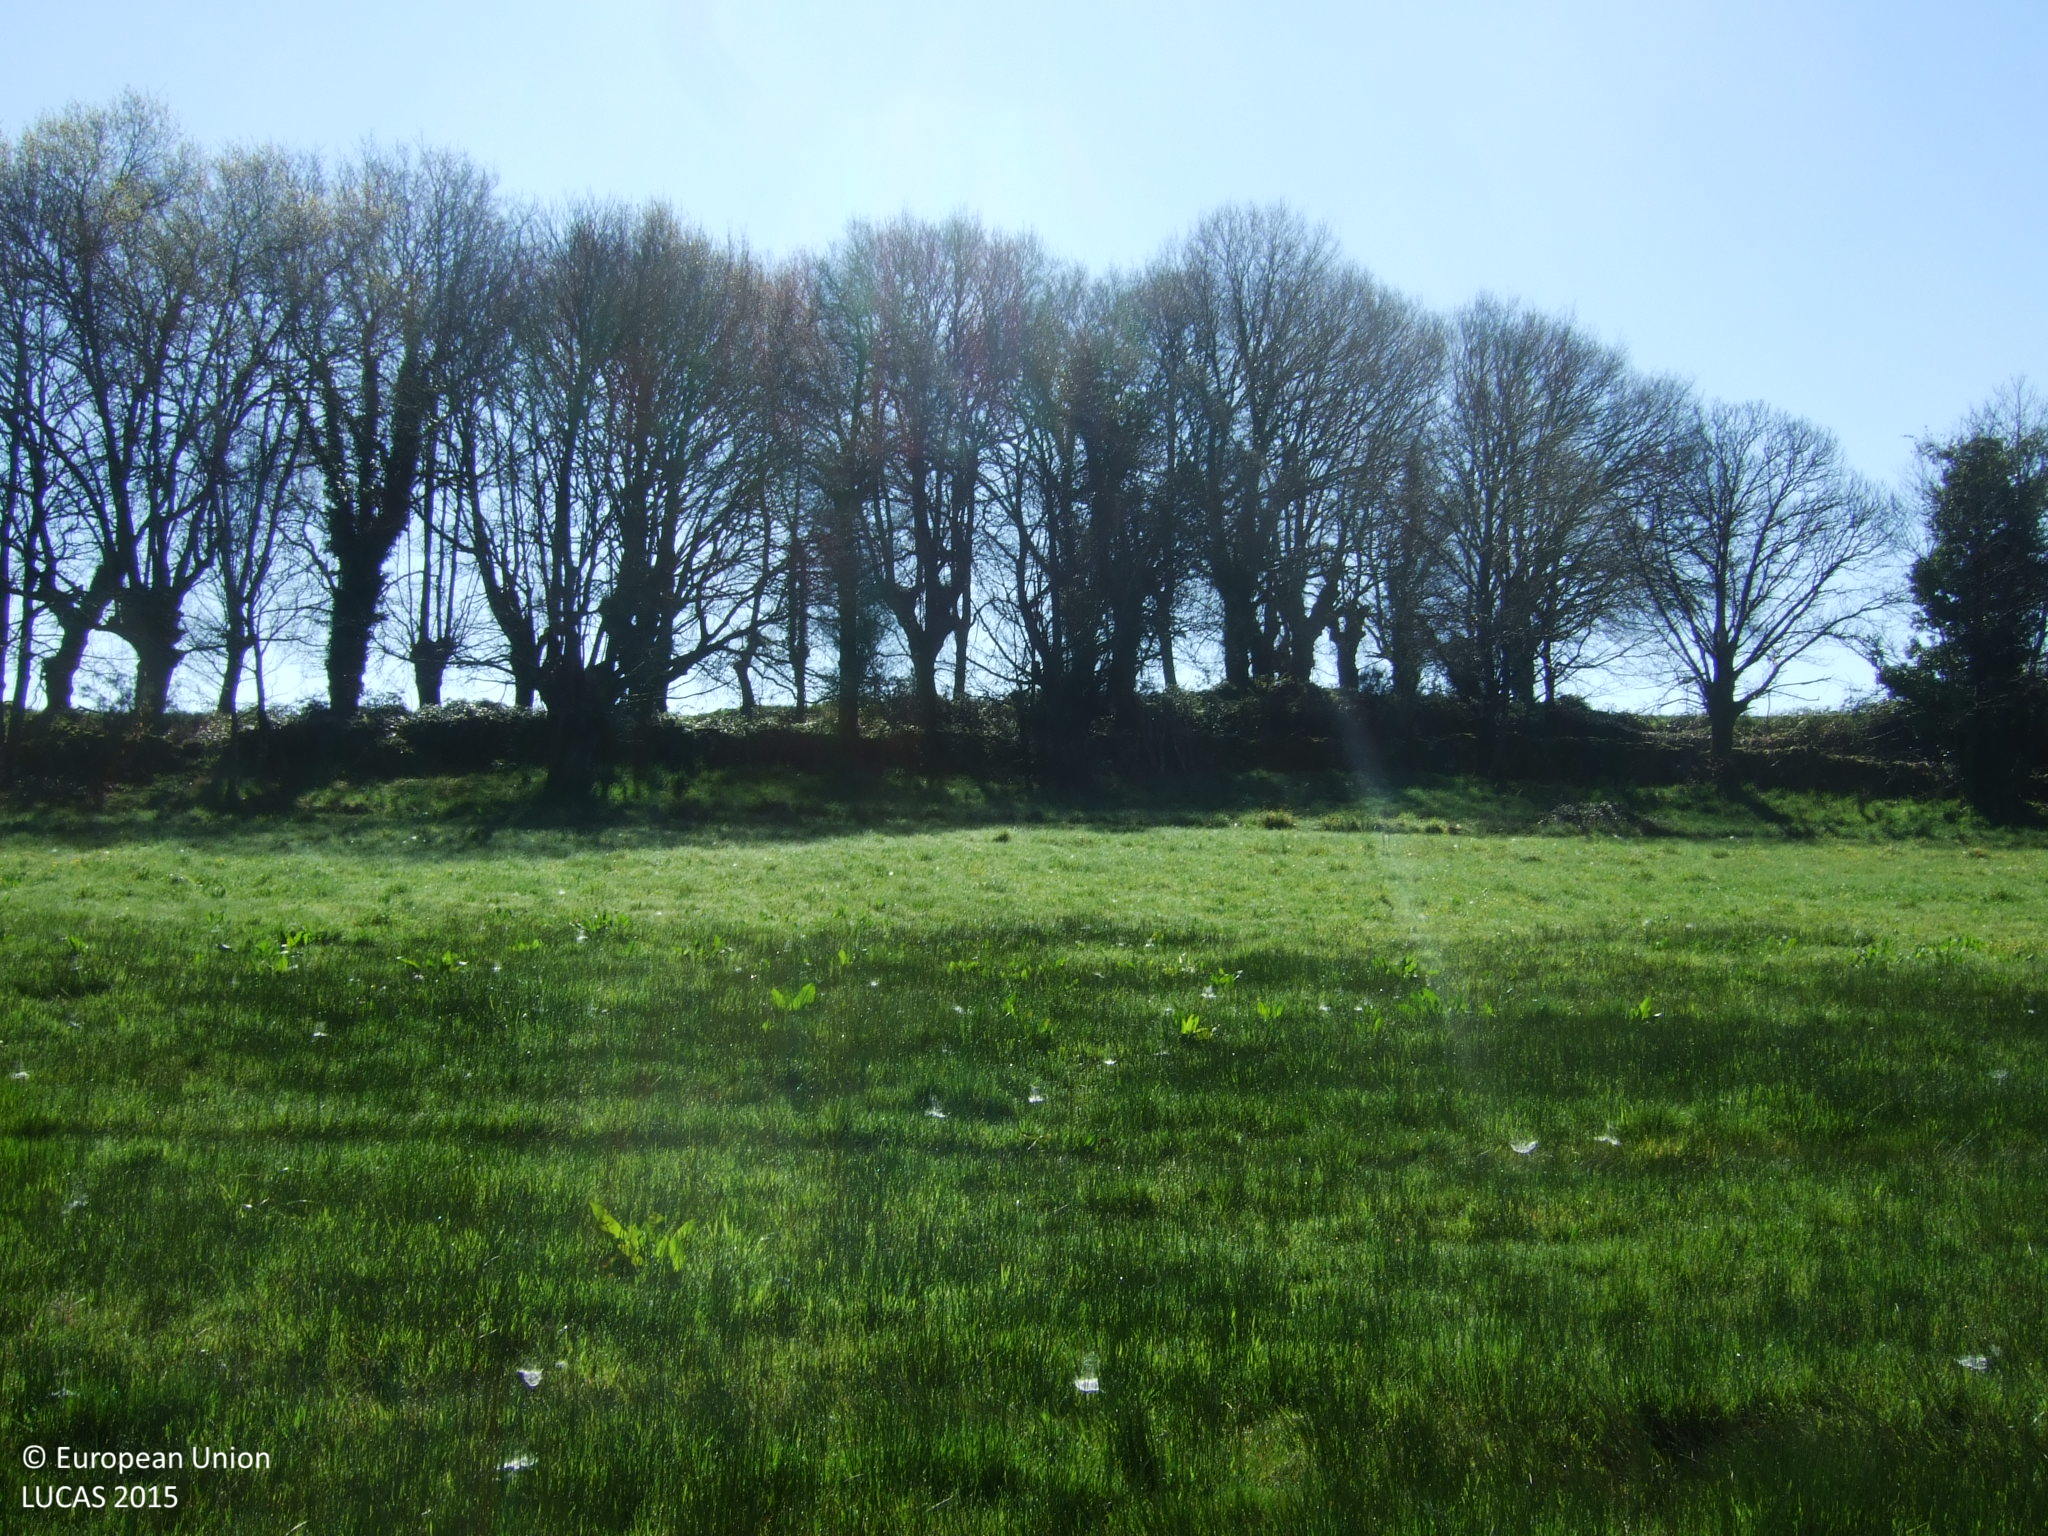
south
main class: Grassland
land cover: Grassland without tree/shrub cover
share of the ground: > 75 %
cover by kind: herbaceous plants 100 %
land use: Agriculture (excluding fallow land and kitchen gardens)
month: April
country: ES
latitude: 42.6965
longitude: -7.8422
